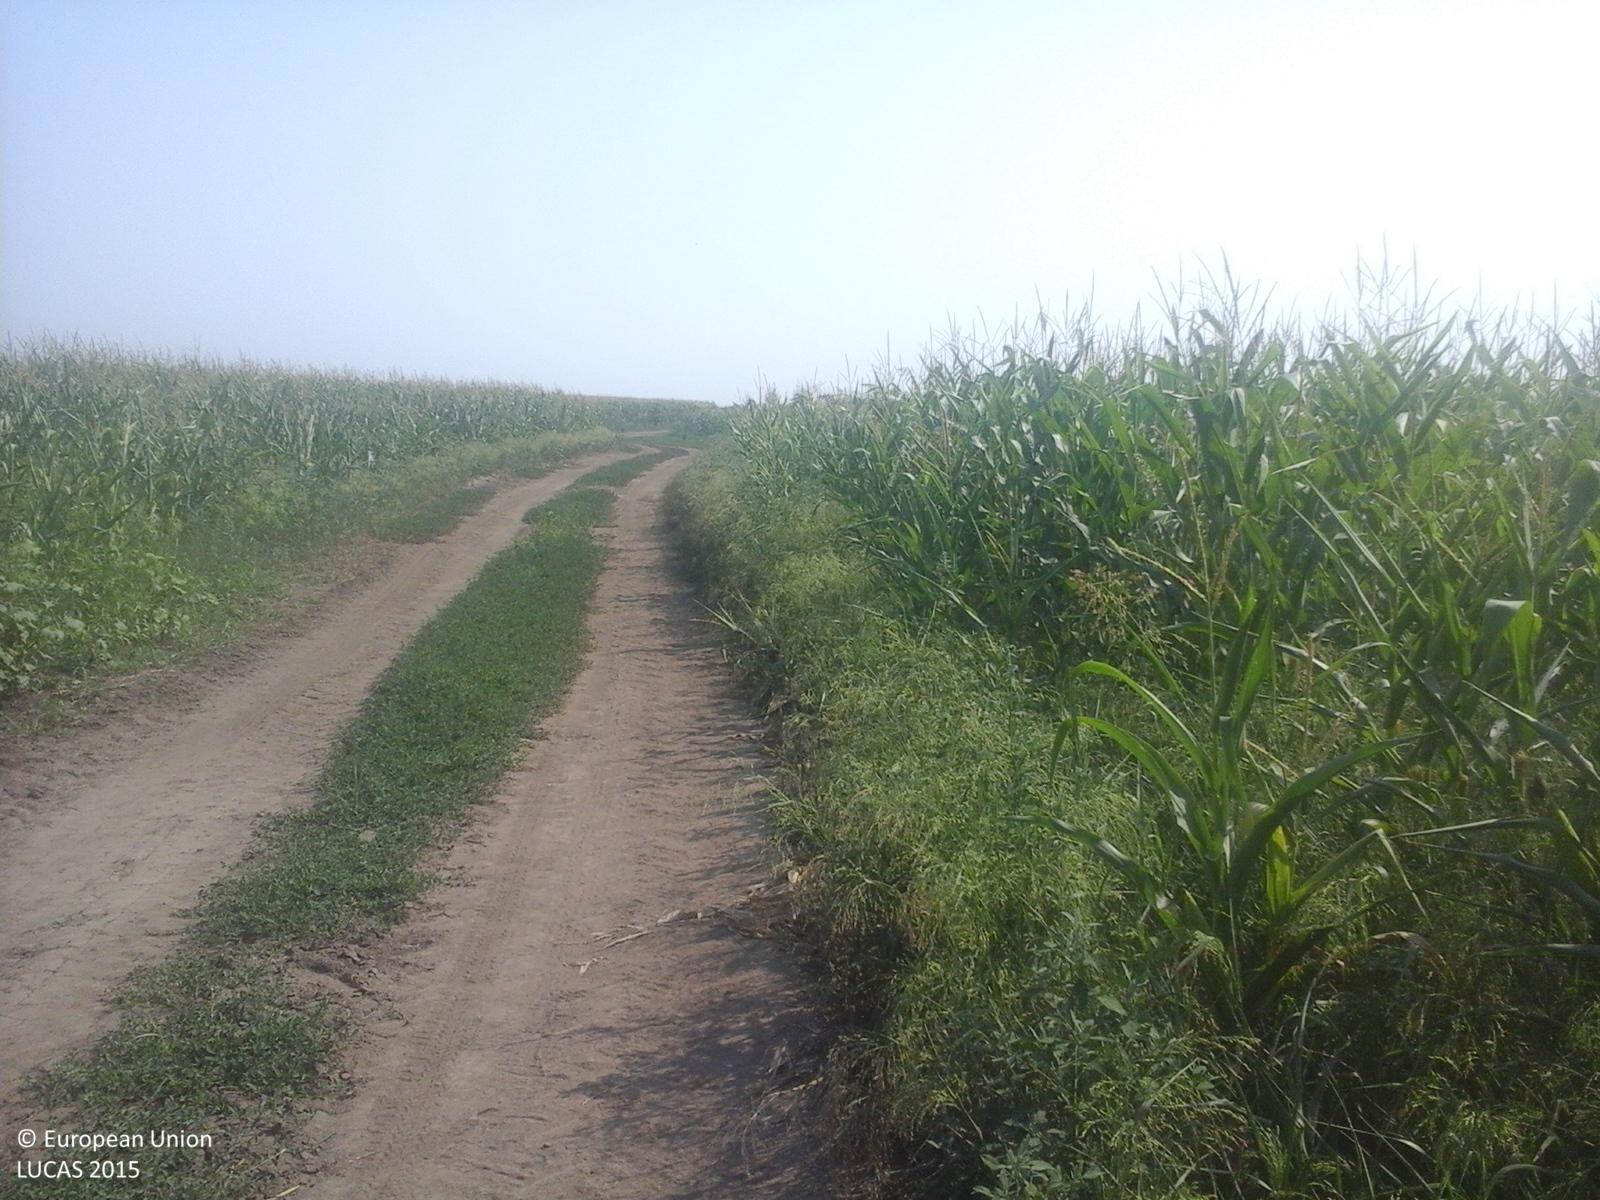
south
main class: Cropland
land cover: Maize
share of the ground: > 75 %
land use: Agriculture (excluding fallow land and kitchen gardens)
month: July
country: RO
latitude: 44.9380
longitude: 26.7918
